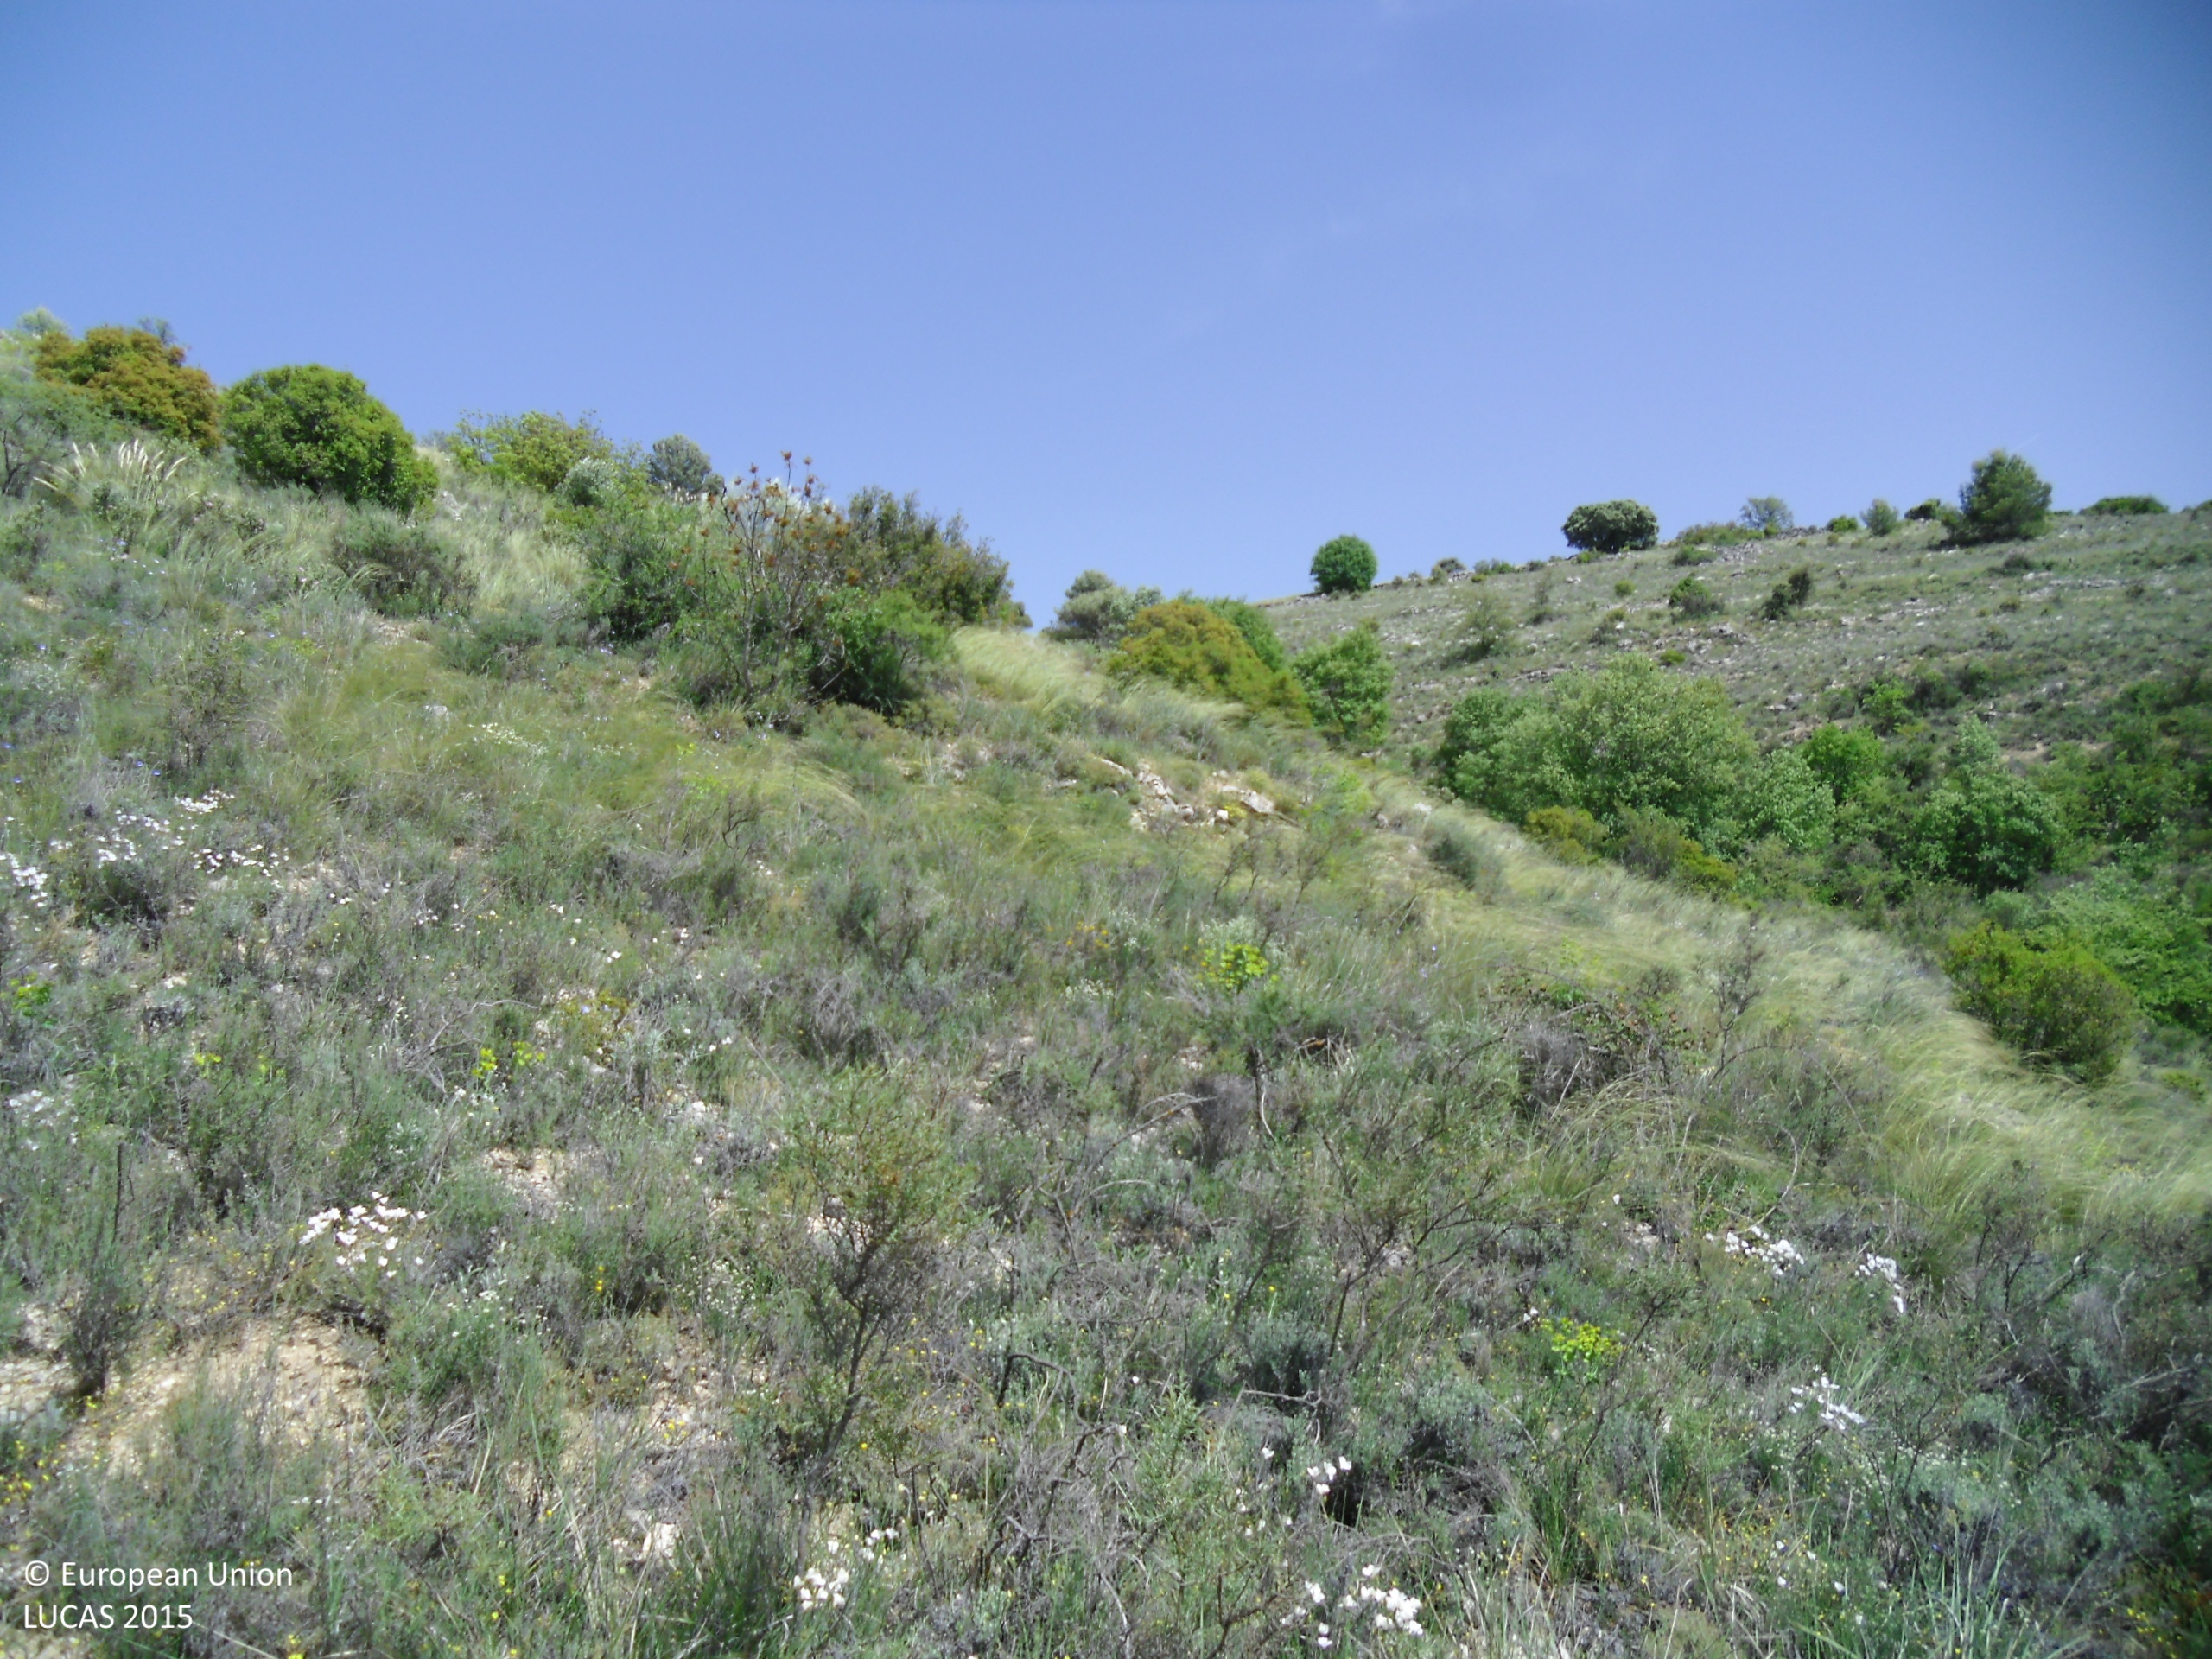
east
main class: Shrubland
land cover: Shrubland with sparse tree cover
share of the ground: 25 - 50 %
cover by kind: herbaceous plants 50 %, shrubs 45 %, broadleaved forest trees 5 %
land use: Semi-natural and natural areas not in use
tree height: < 5 m
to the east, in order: Shrubland with sparse tree cover; Olive groves
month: May
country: ES
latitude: 40.4346
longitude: -2.9127
